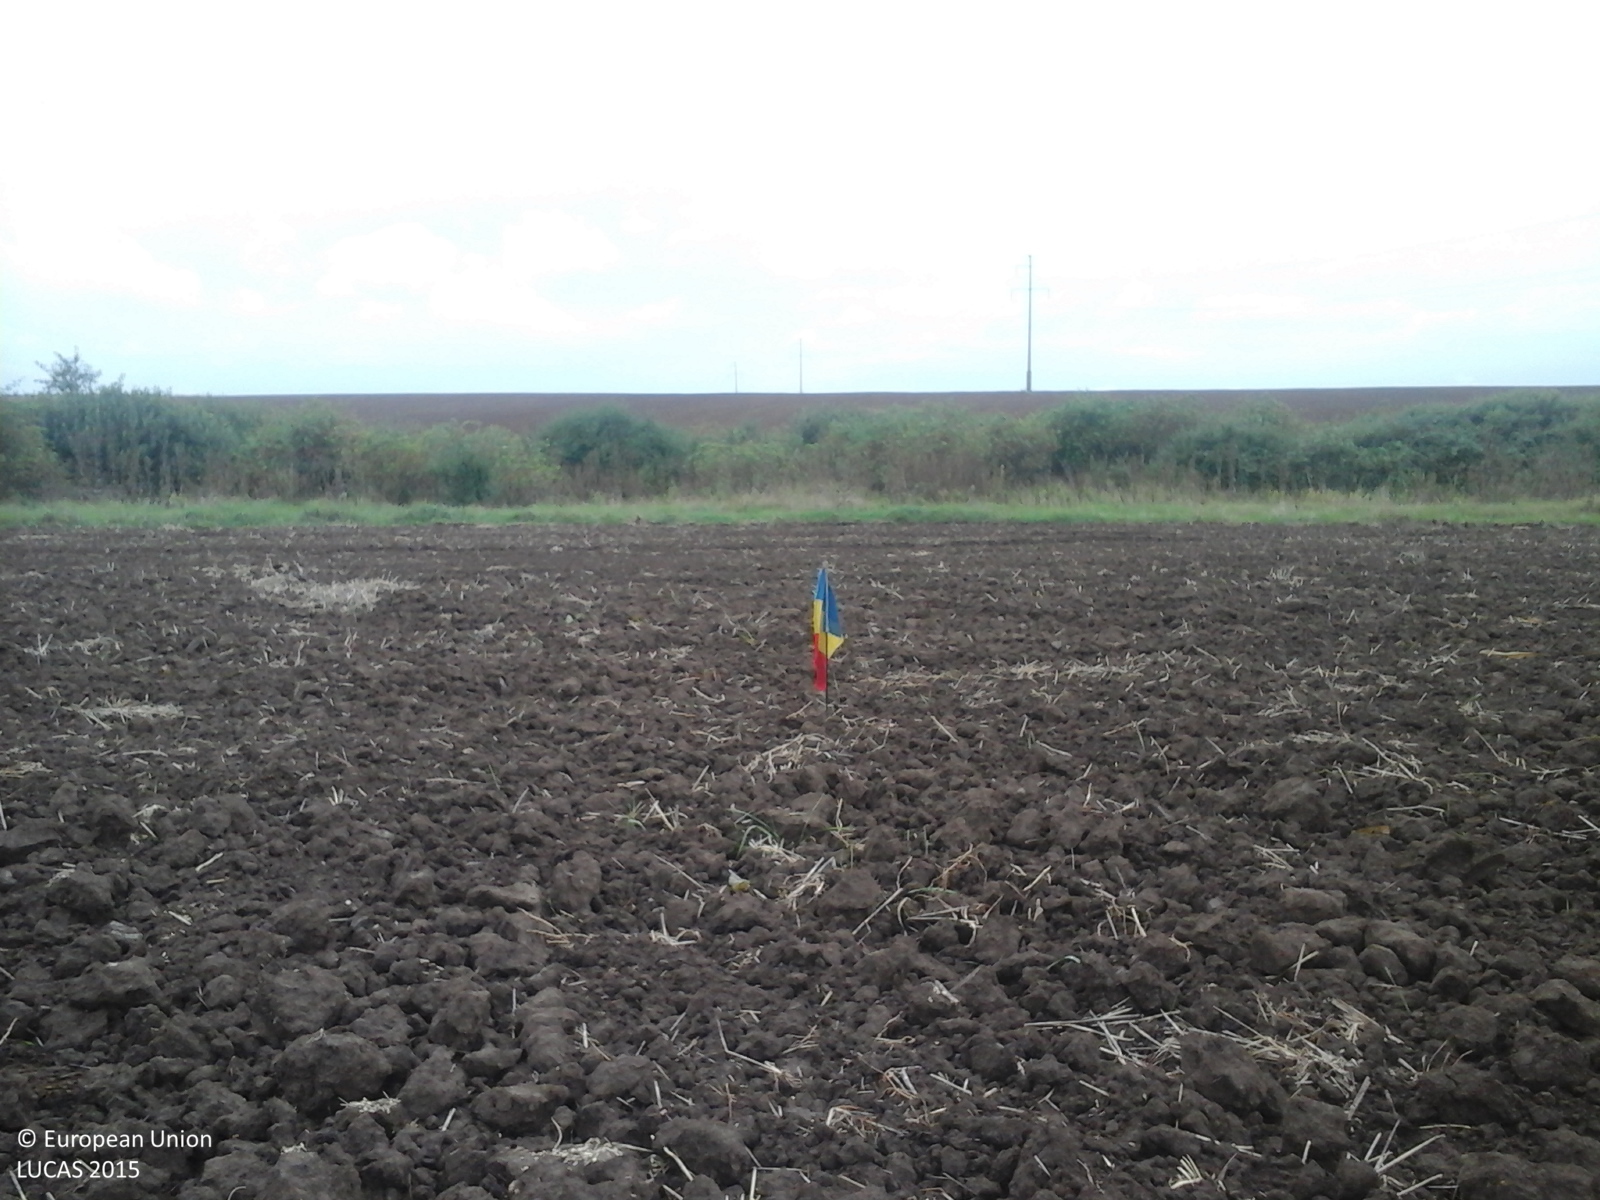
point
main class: Cropland
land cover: Common wheat
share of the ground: < 10 %
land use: Agriculture (excluding fallow land and kitchen gardens)
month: September
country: RO
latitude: 47.1962
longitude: 22.0470
